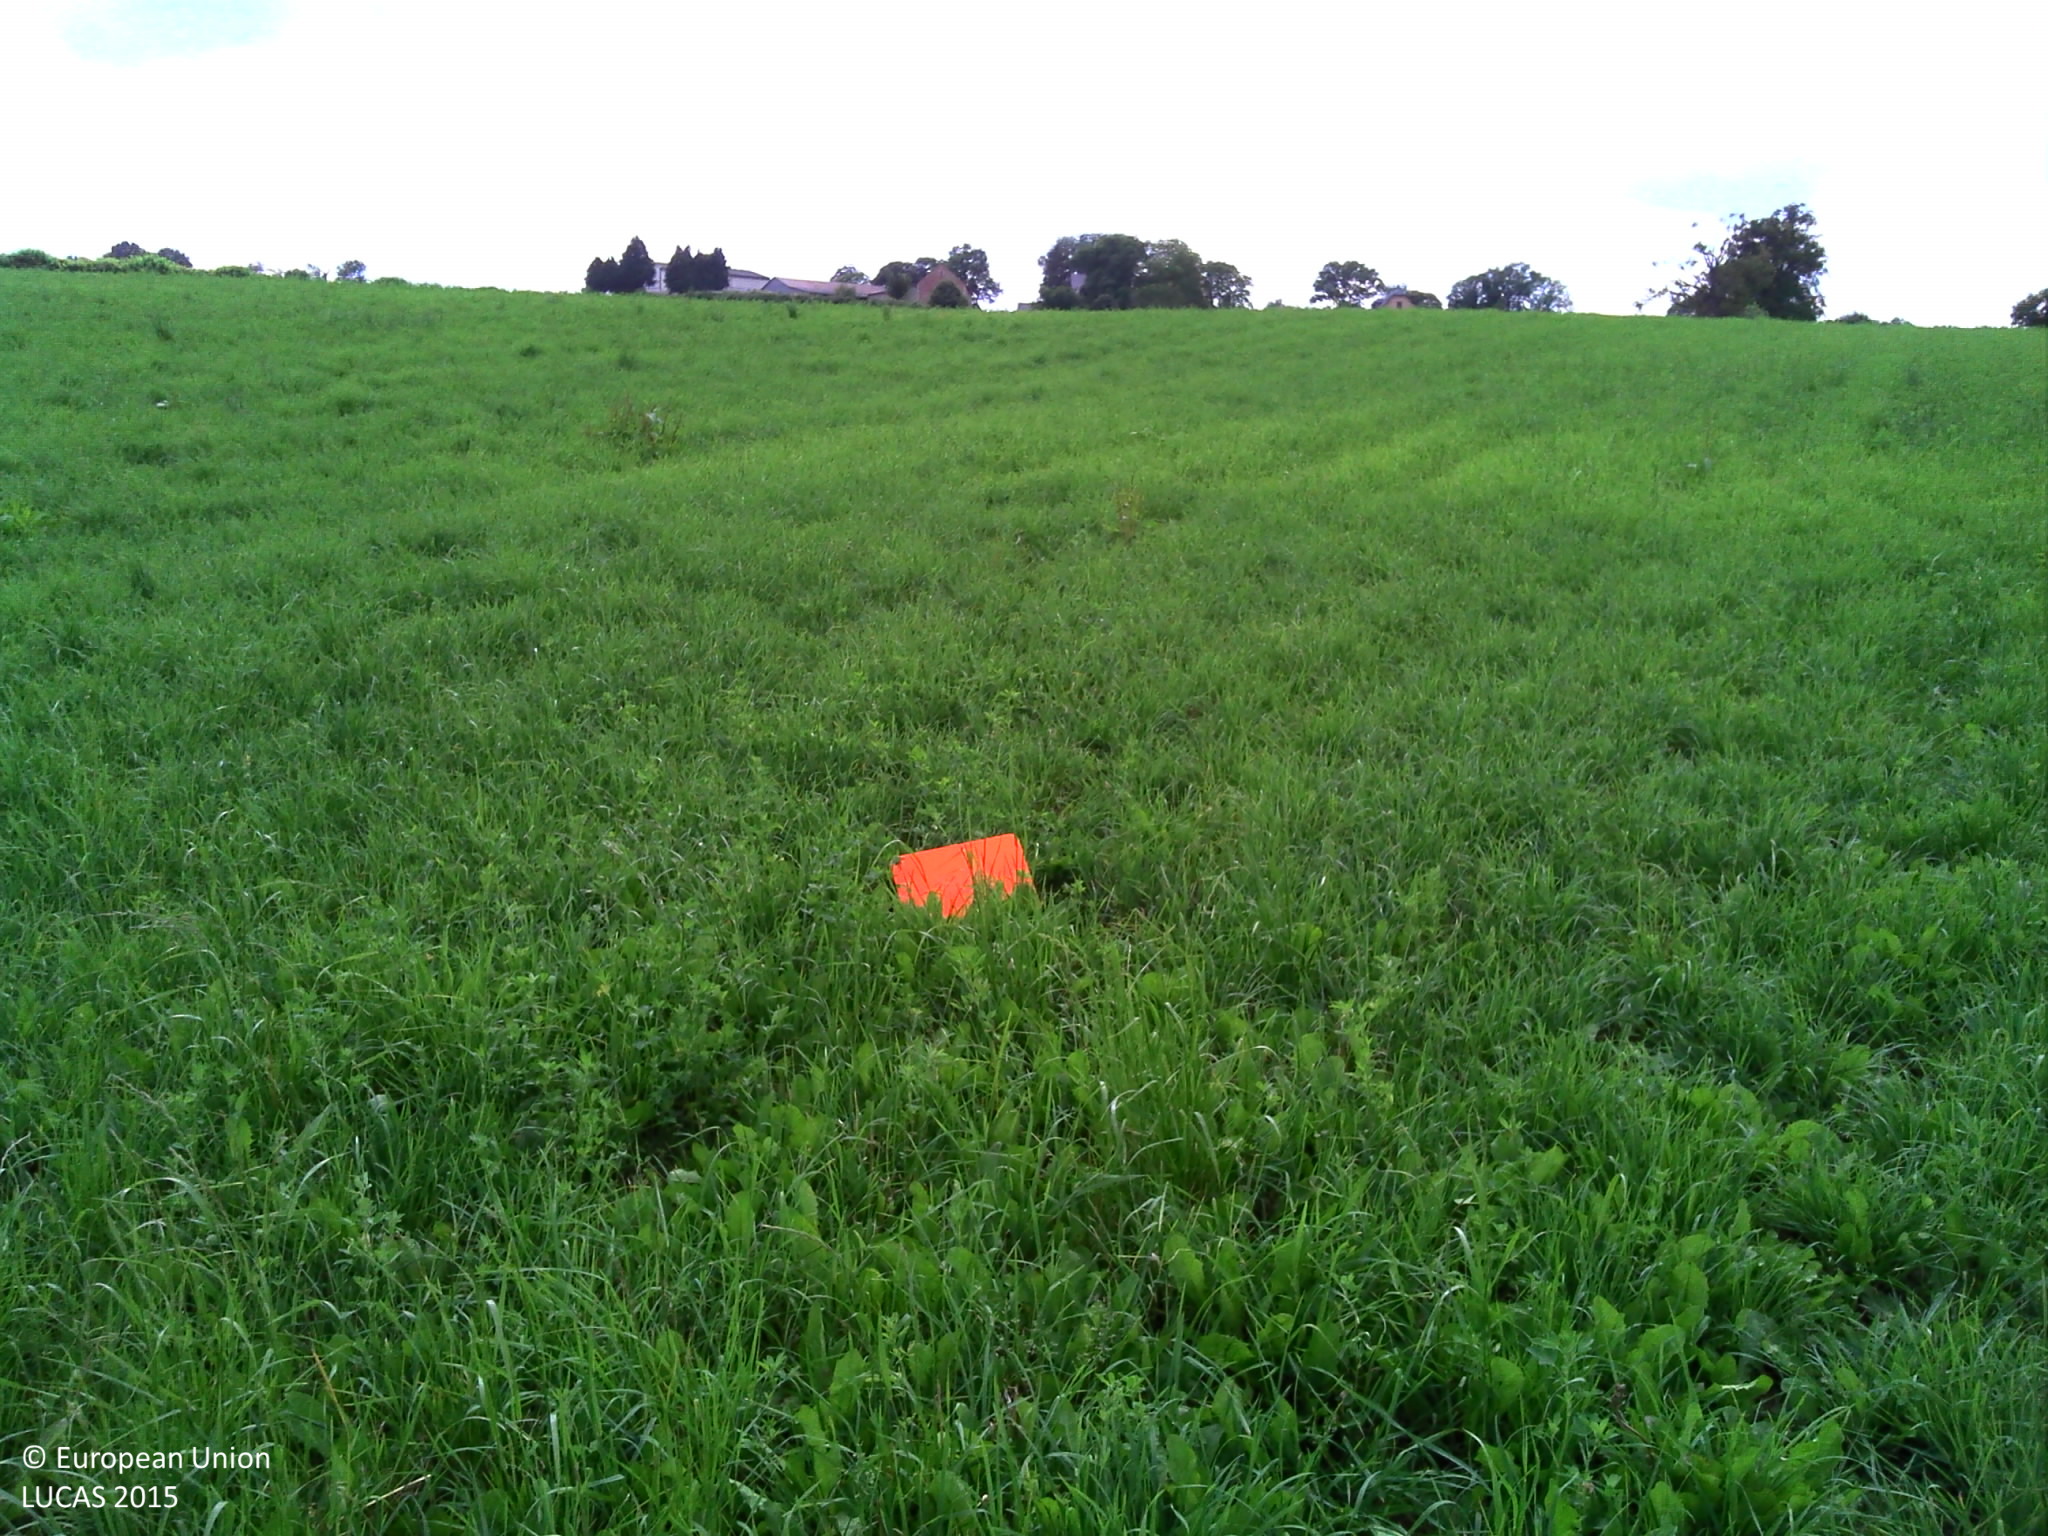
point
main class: Cropland
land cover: Temporary grasslands
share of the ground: > 75 %
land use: Agriculture (excluding fallow land and kitchen gardens)
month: June
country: FR
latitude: 44.3013
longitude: 2.5706
